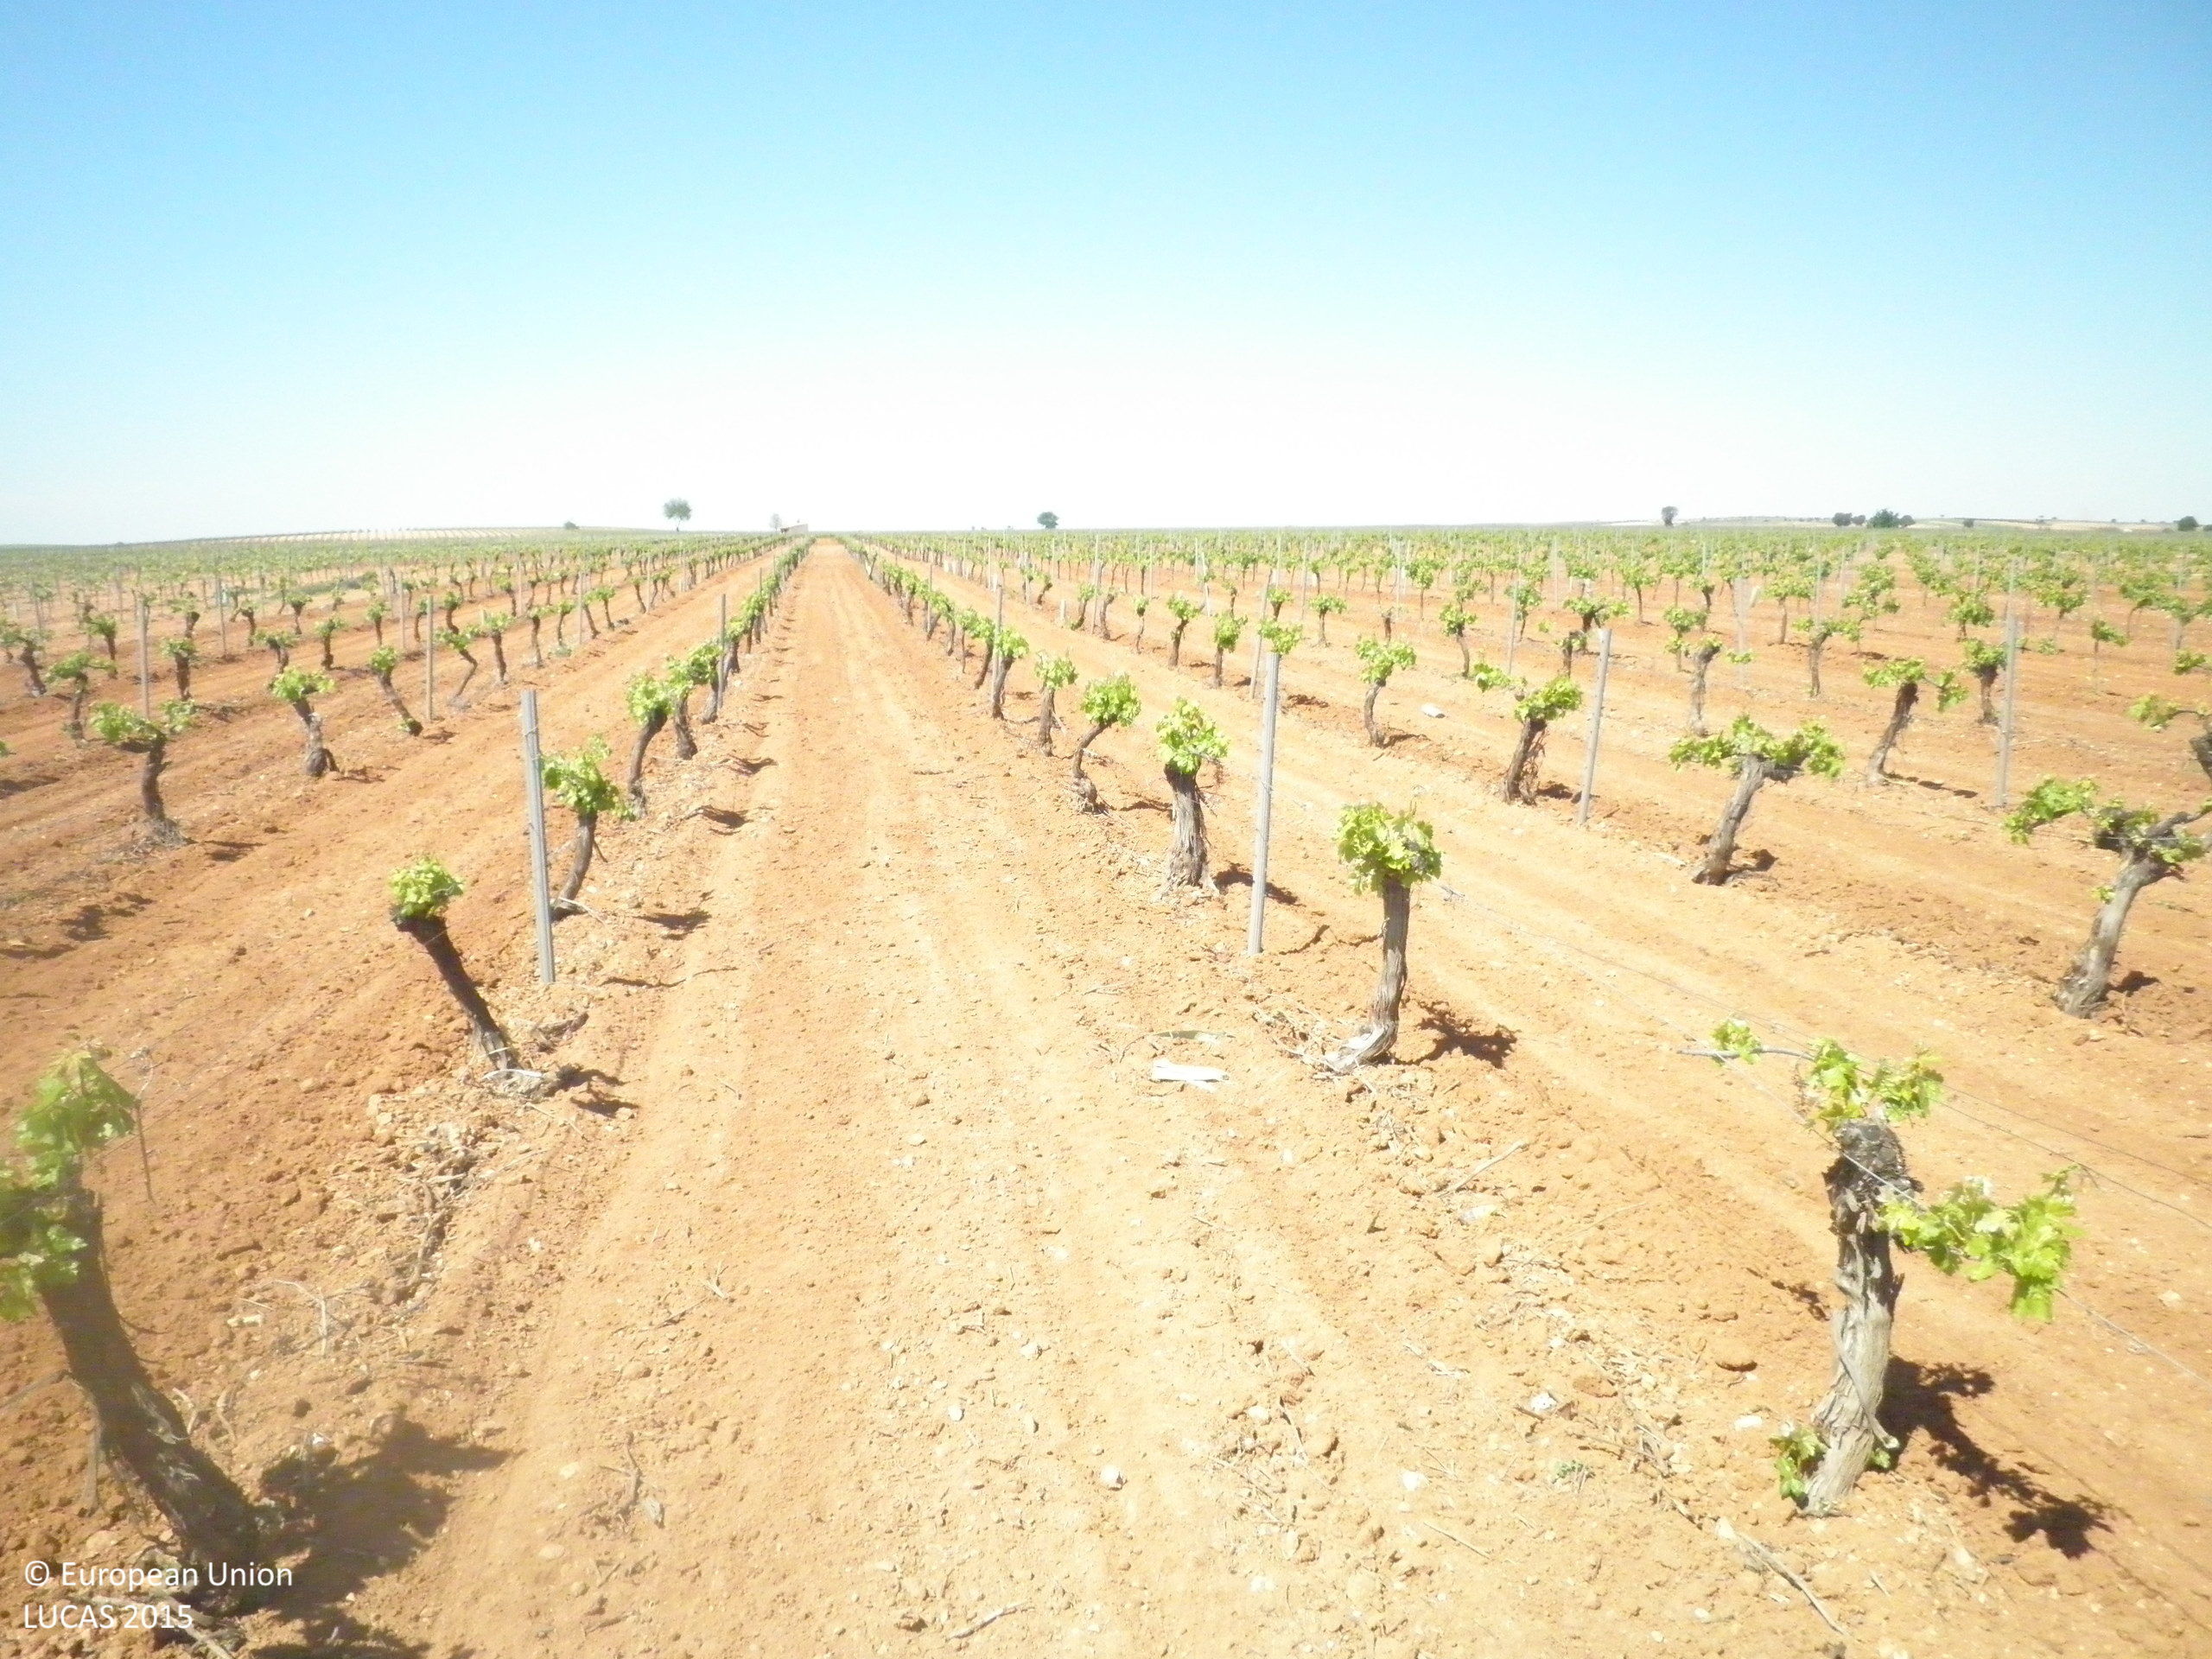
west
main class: Cropland
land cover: Vineyards
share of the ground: < 10 %
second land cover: Other bare soil
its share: > 75 %
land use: Agriculture (excluding fallow land and kitchen gardens)
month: May
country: ES
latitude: 39.4277
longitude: -2.7809
